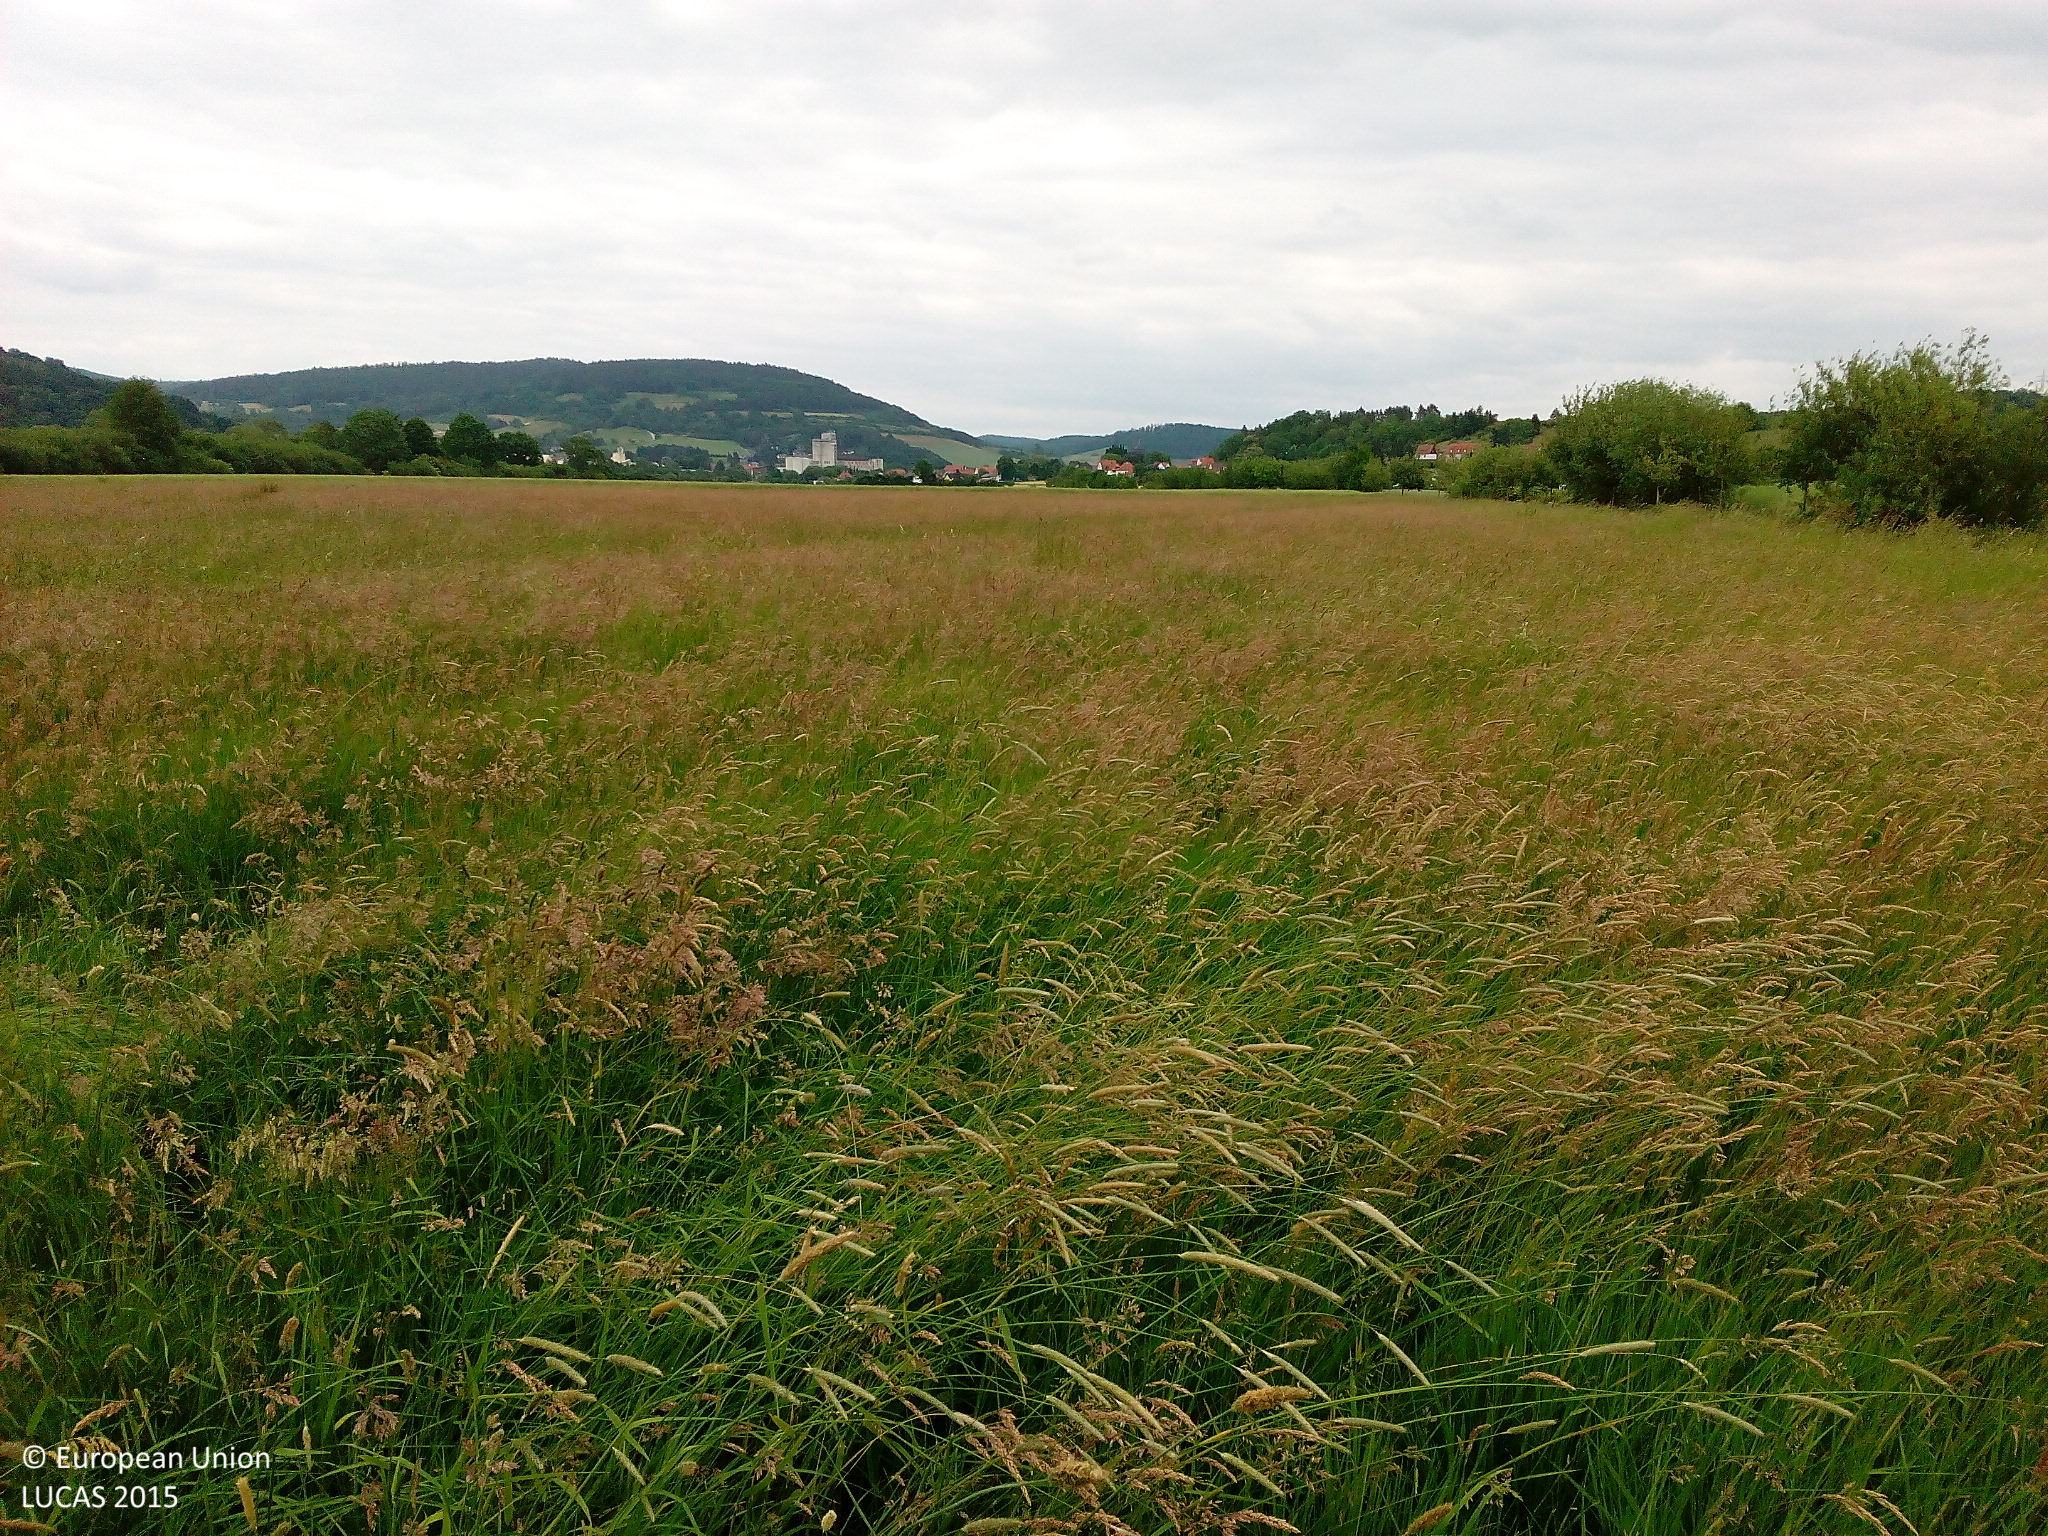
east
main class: Grassland
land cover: Grassland without tree/shrub cover
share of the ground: > 75 %
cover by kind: herbaceous plants 100 %
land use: Agriculture (excluding fallow land and kitchen gardens)
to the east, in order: Grassland without tree/shrub cover; Rye
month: June
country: DE
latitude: 51.0645
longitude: 9.5863
